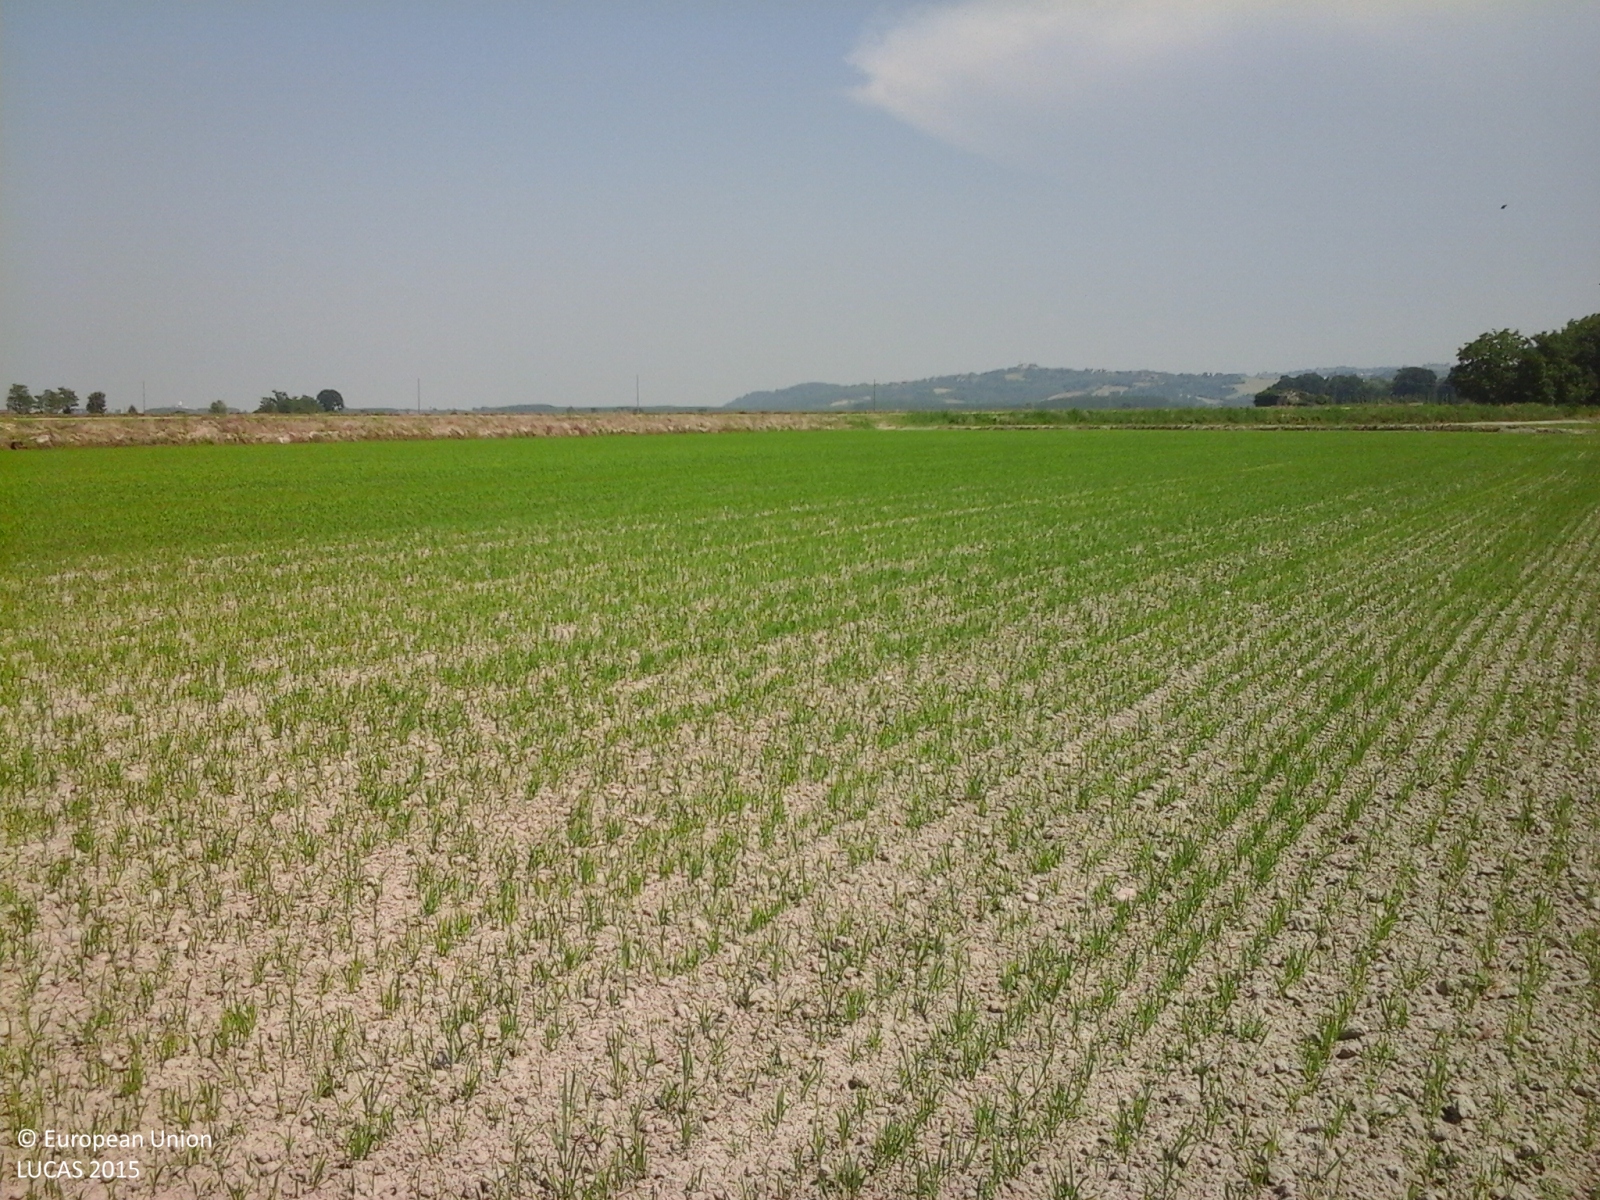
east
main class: Cropland
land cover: Rice
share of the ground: 25 - 50 %
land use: Agriculture (excluding fallow land and kitchen gardens)
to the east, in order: Rice; Ditches and canals; Rice; Ditches and canals; Rice; Other structural elements; Rice; Other structural elements; Ditches and canals; Grass margins; Tracks; Grass margins; Ditches and canals; Other structural elements; Rice
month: June
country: IT
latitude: 45.1664
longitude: 8.3109
